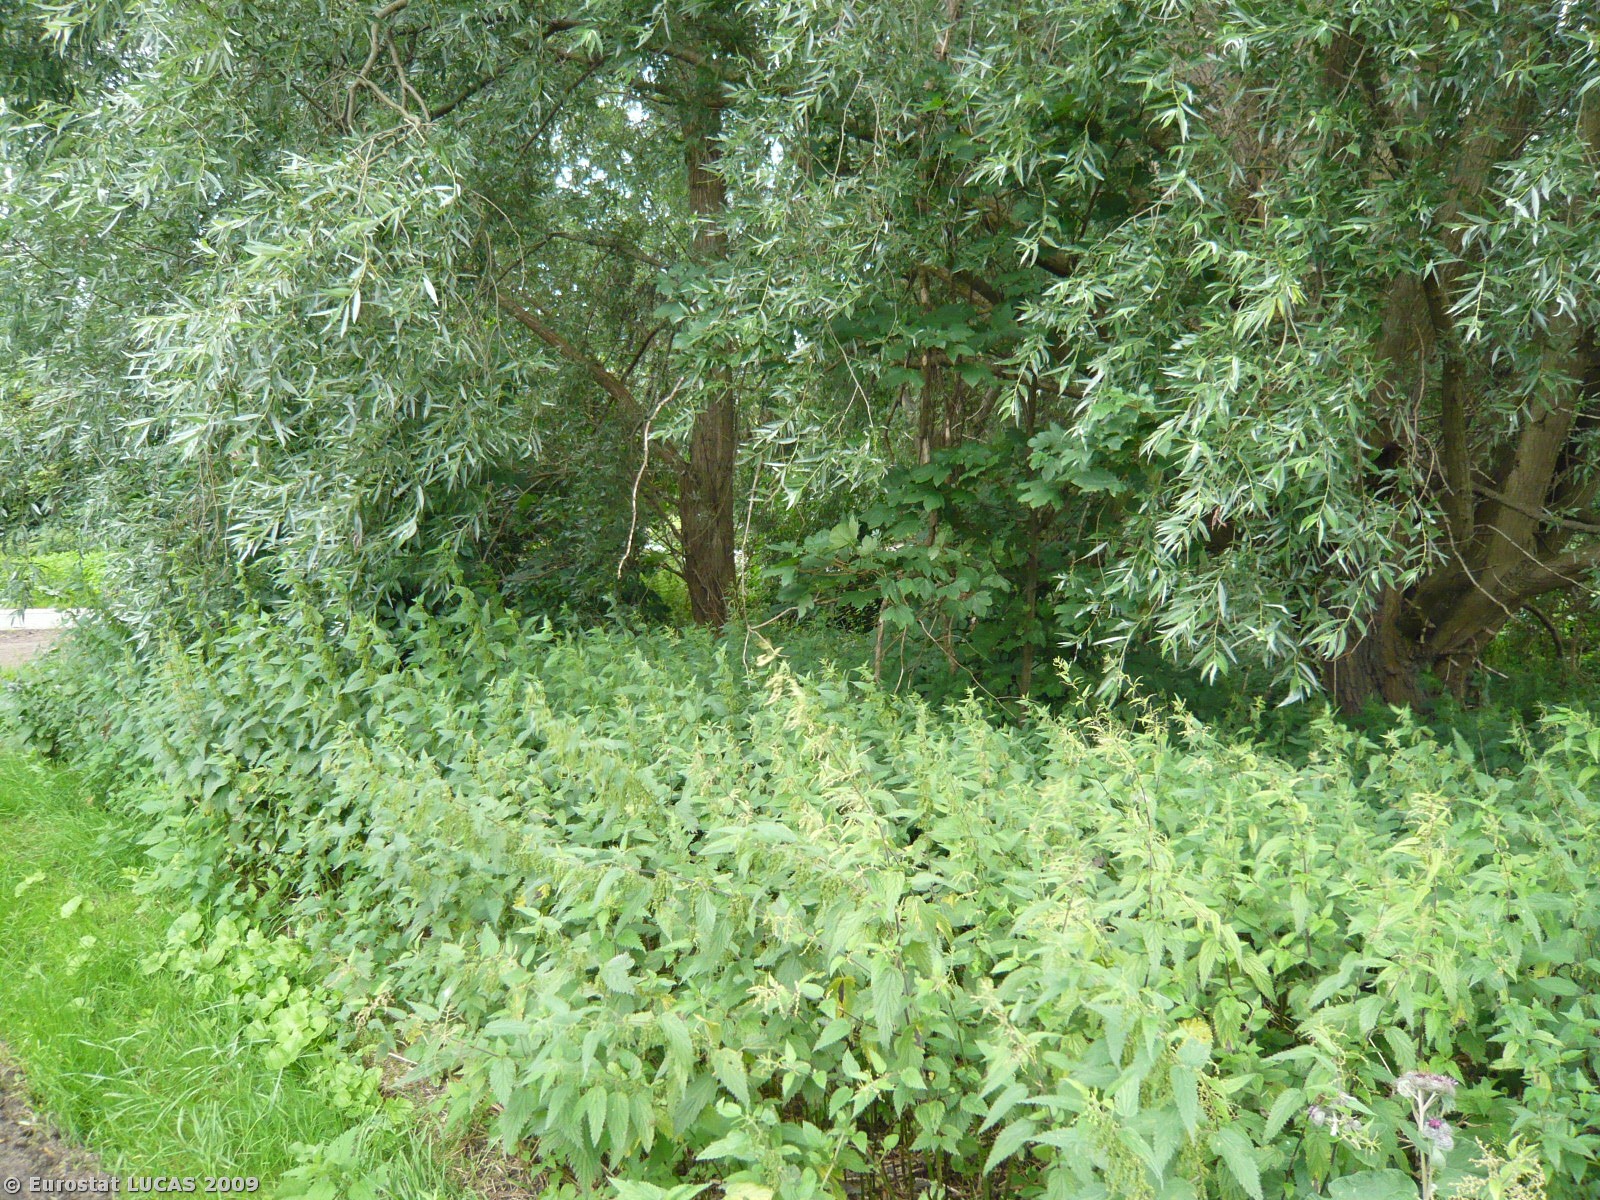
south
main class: Woodland
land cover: Broadleaved woodland
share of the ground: > 75 %
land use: Unused
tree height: < 5 m
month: July
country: DK
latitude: 55.4862
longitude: 12.1663
